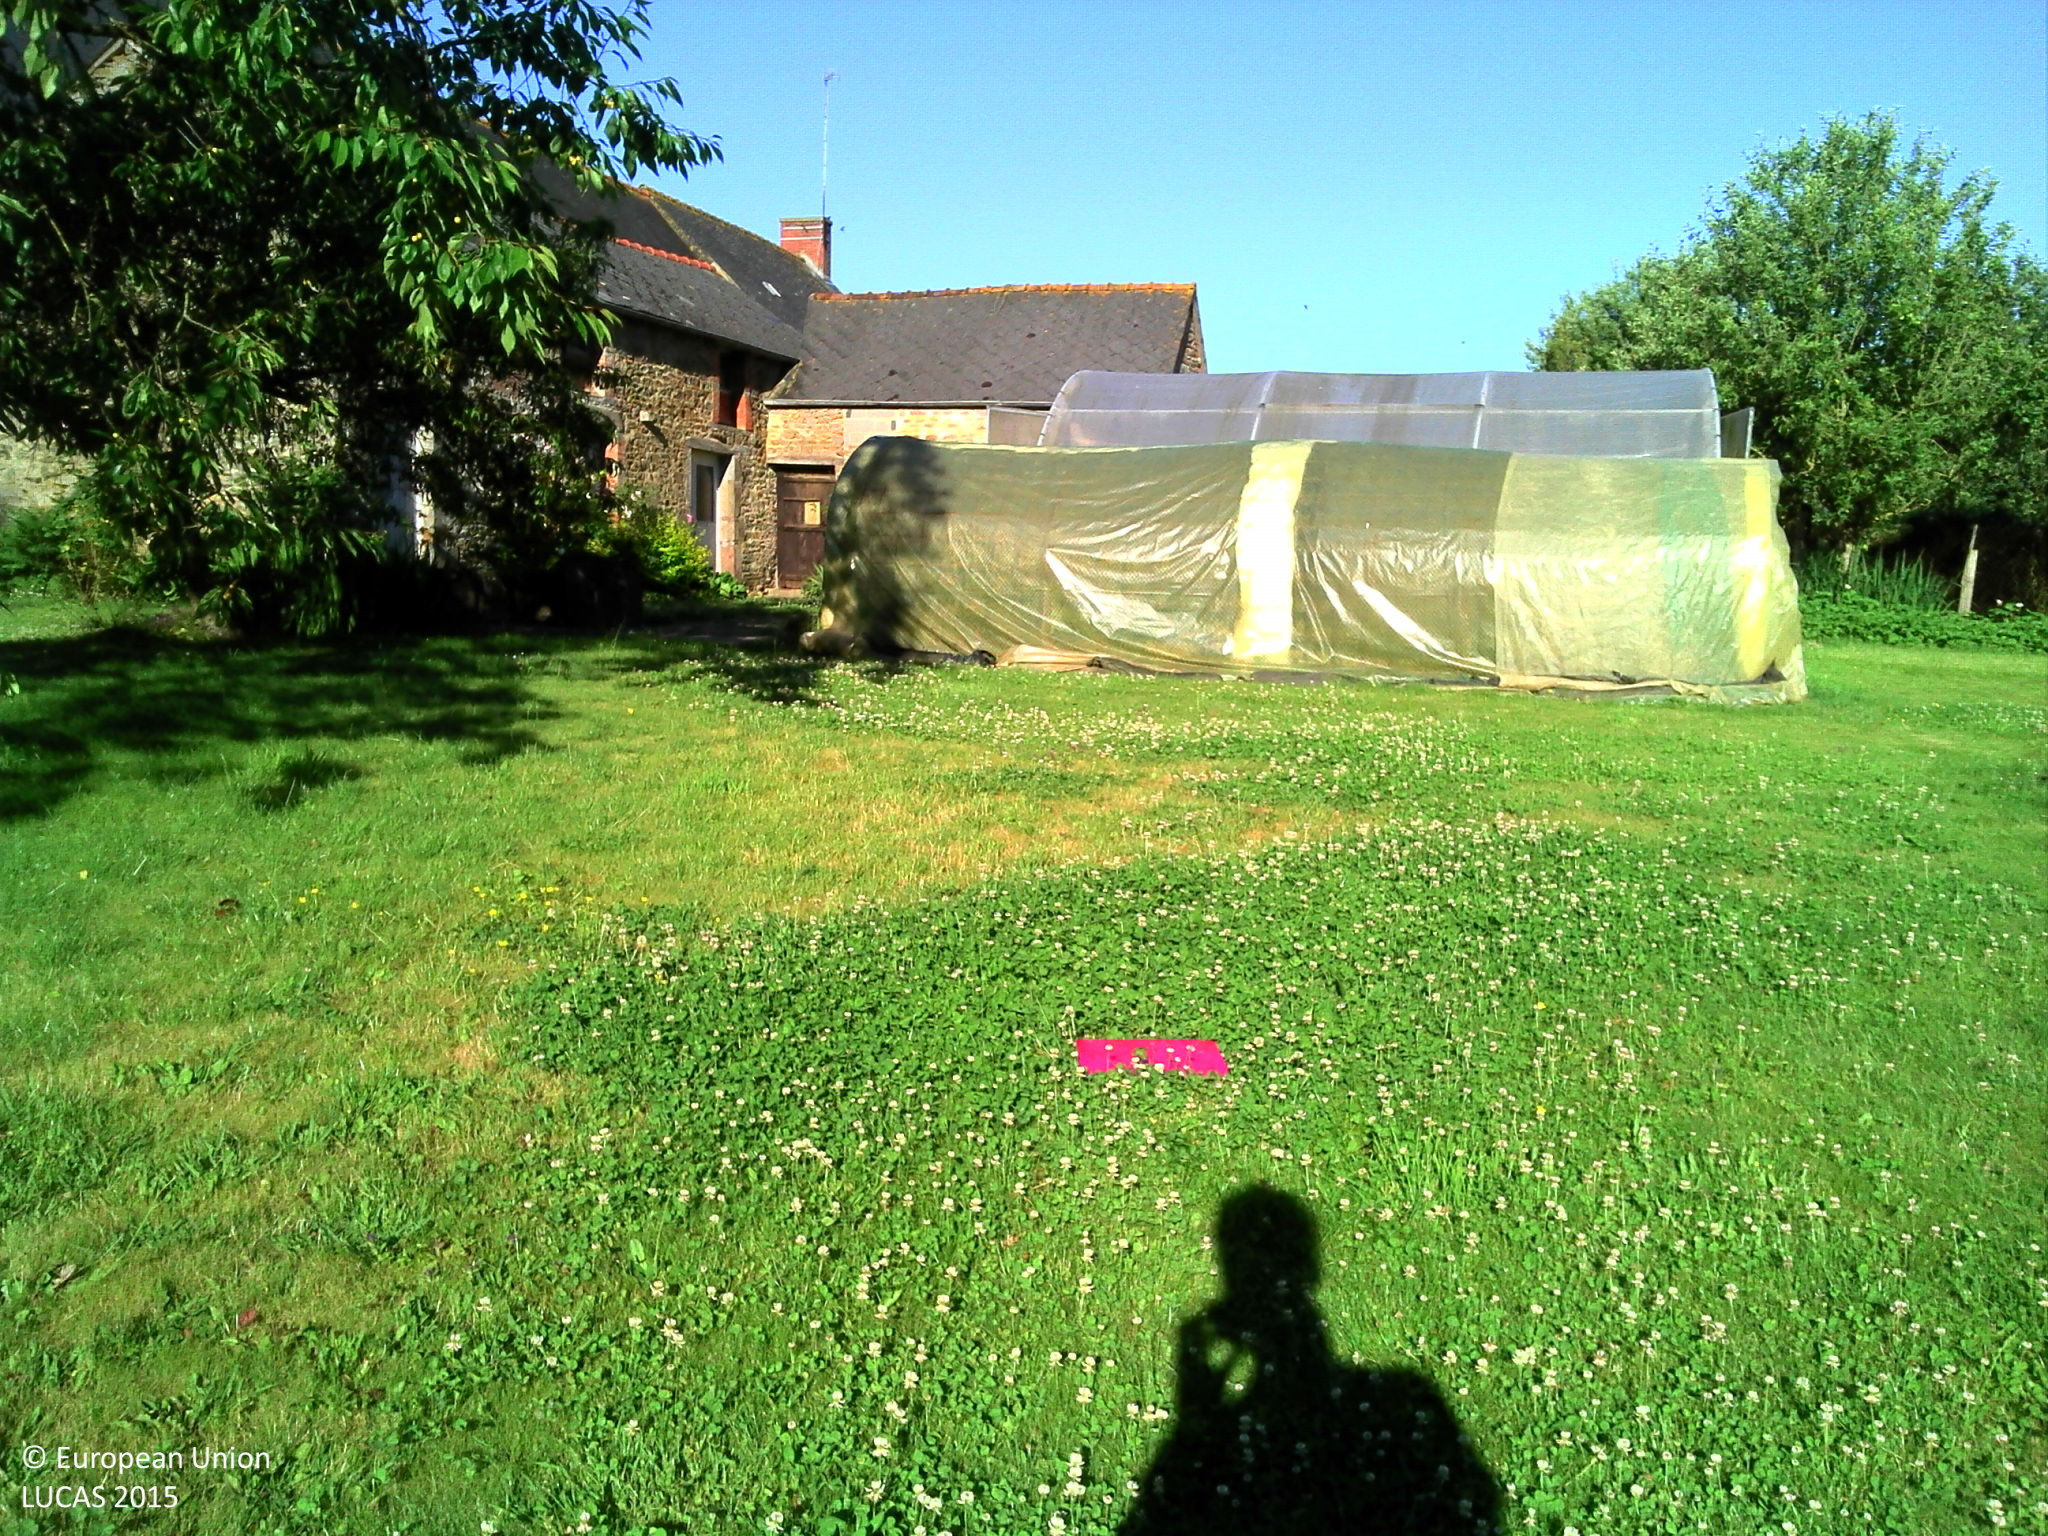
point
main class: Grassland
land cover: Grassland with sparse tree/shrub cover
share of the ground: > 75 %
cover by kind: herbaceous plants 95 %, broadleaved forest trees 5 %
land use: Residential
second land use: Agriculture (excluding fallow land and kitchen gardens)
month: June
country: FR
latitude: 48.5059
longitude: -1.5390
